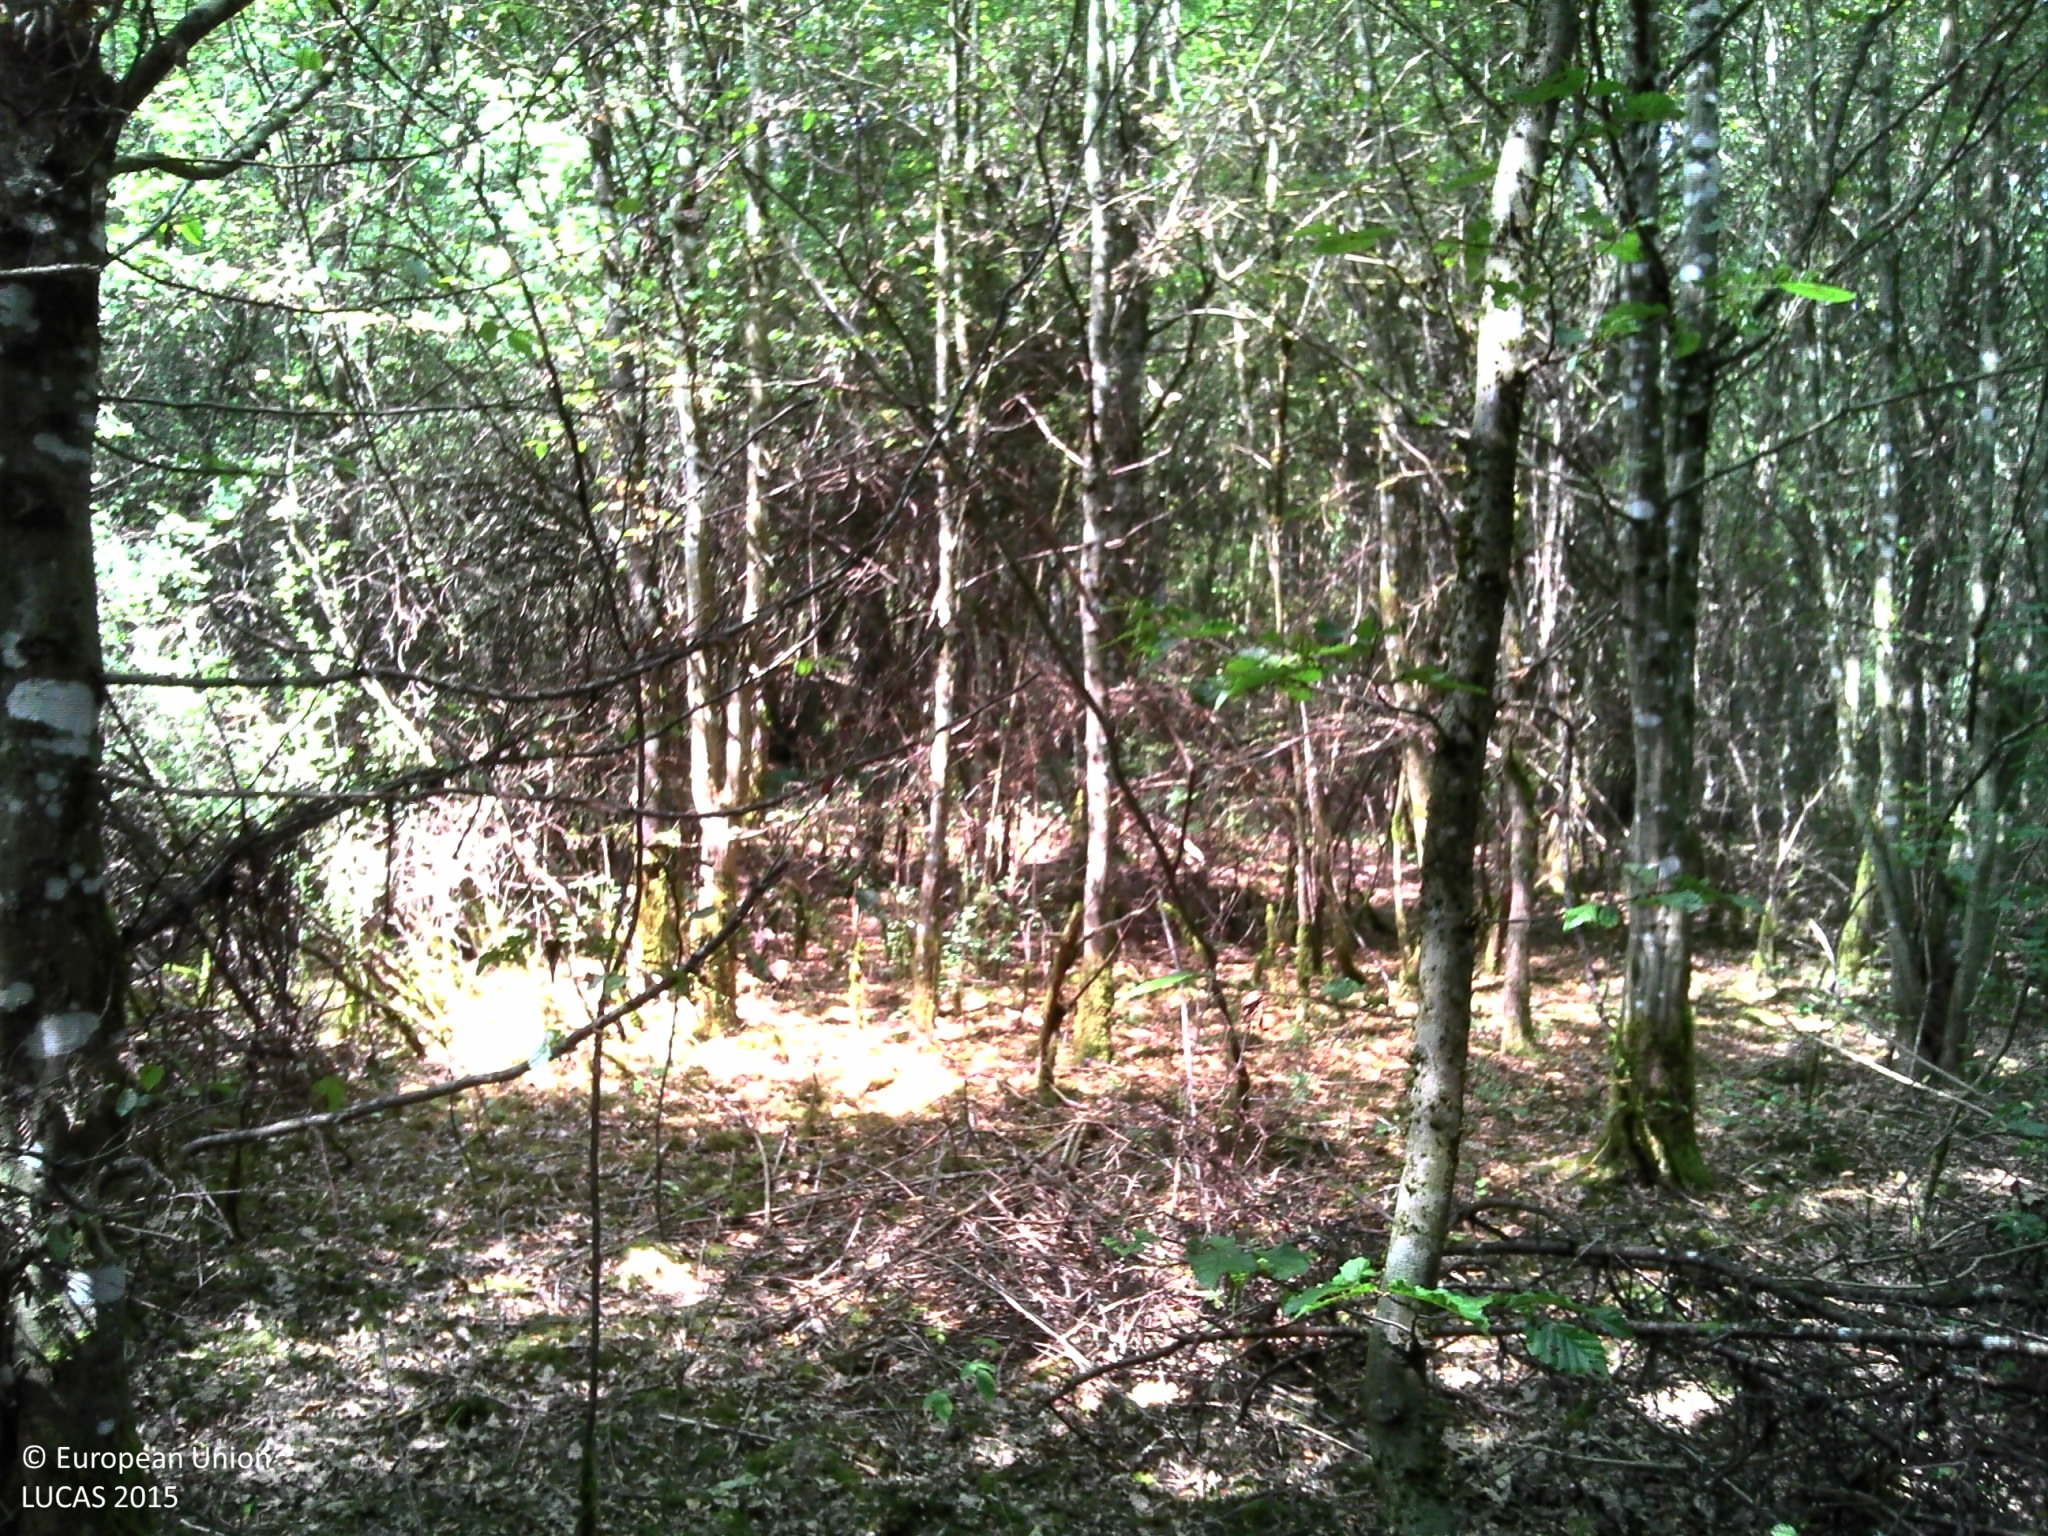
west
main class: Woodland
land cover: Broadleaved woodland
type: mesophytic deciduous forest
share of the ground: > 75 %
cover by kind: broadleaved forest trees 90 %, herbaceous plants 5 %, lichens and mosses 5 %
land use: Forestry
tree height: > 5 m
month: August
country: FR
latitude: 47.7397
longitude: 3.1530
